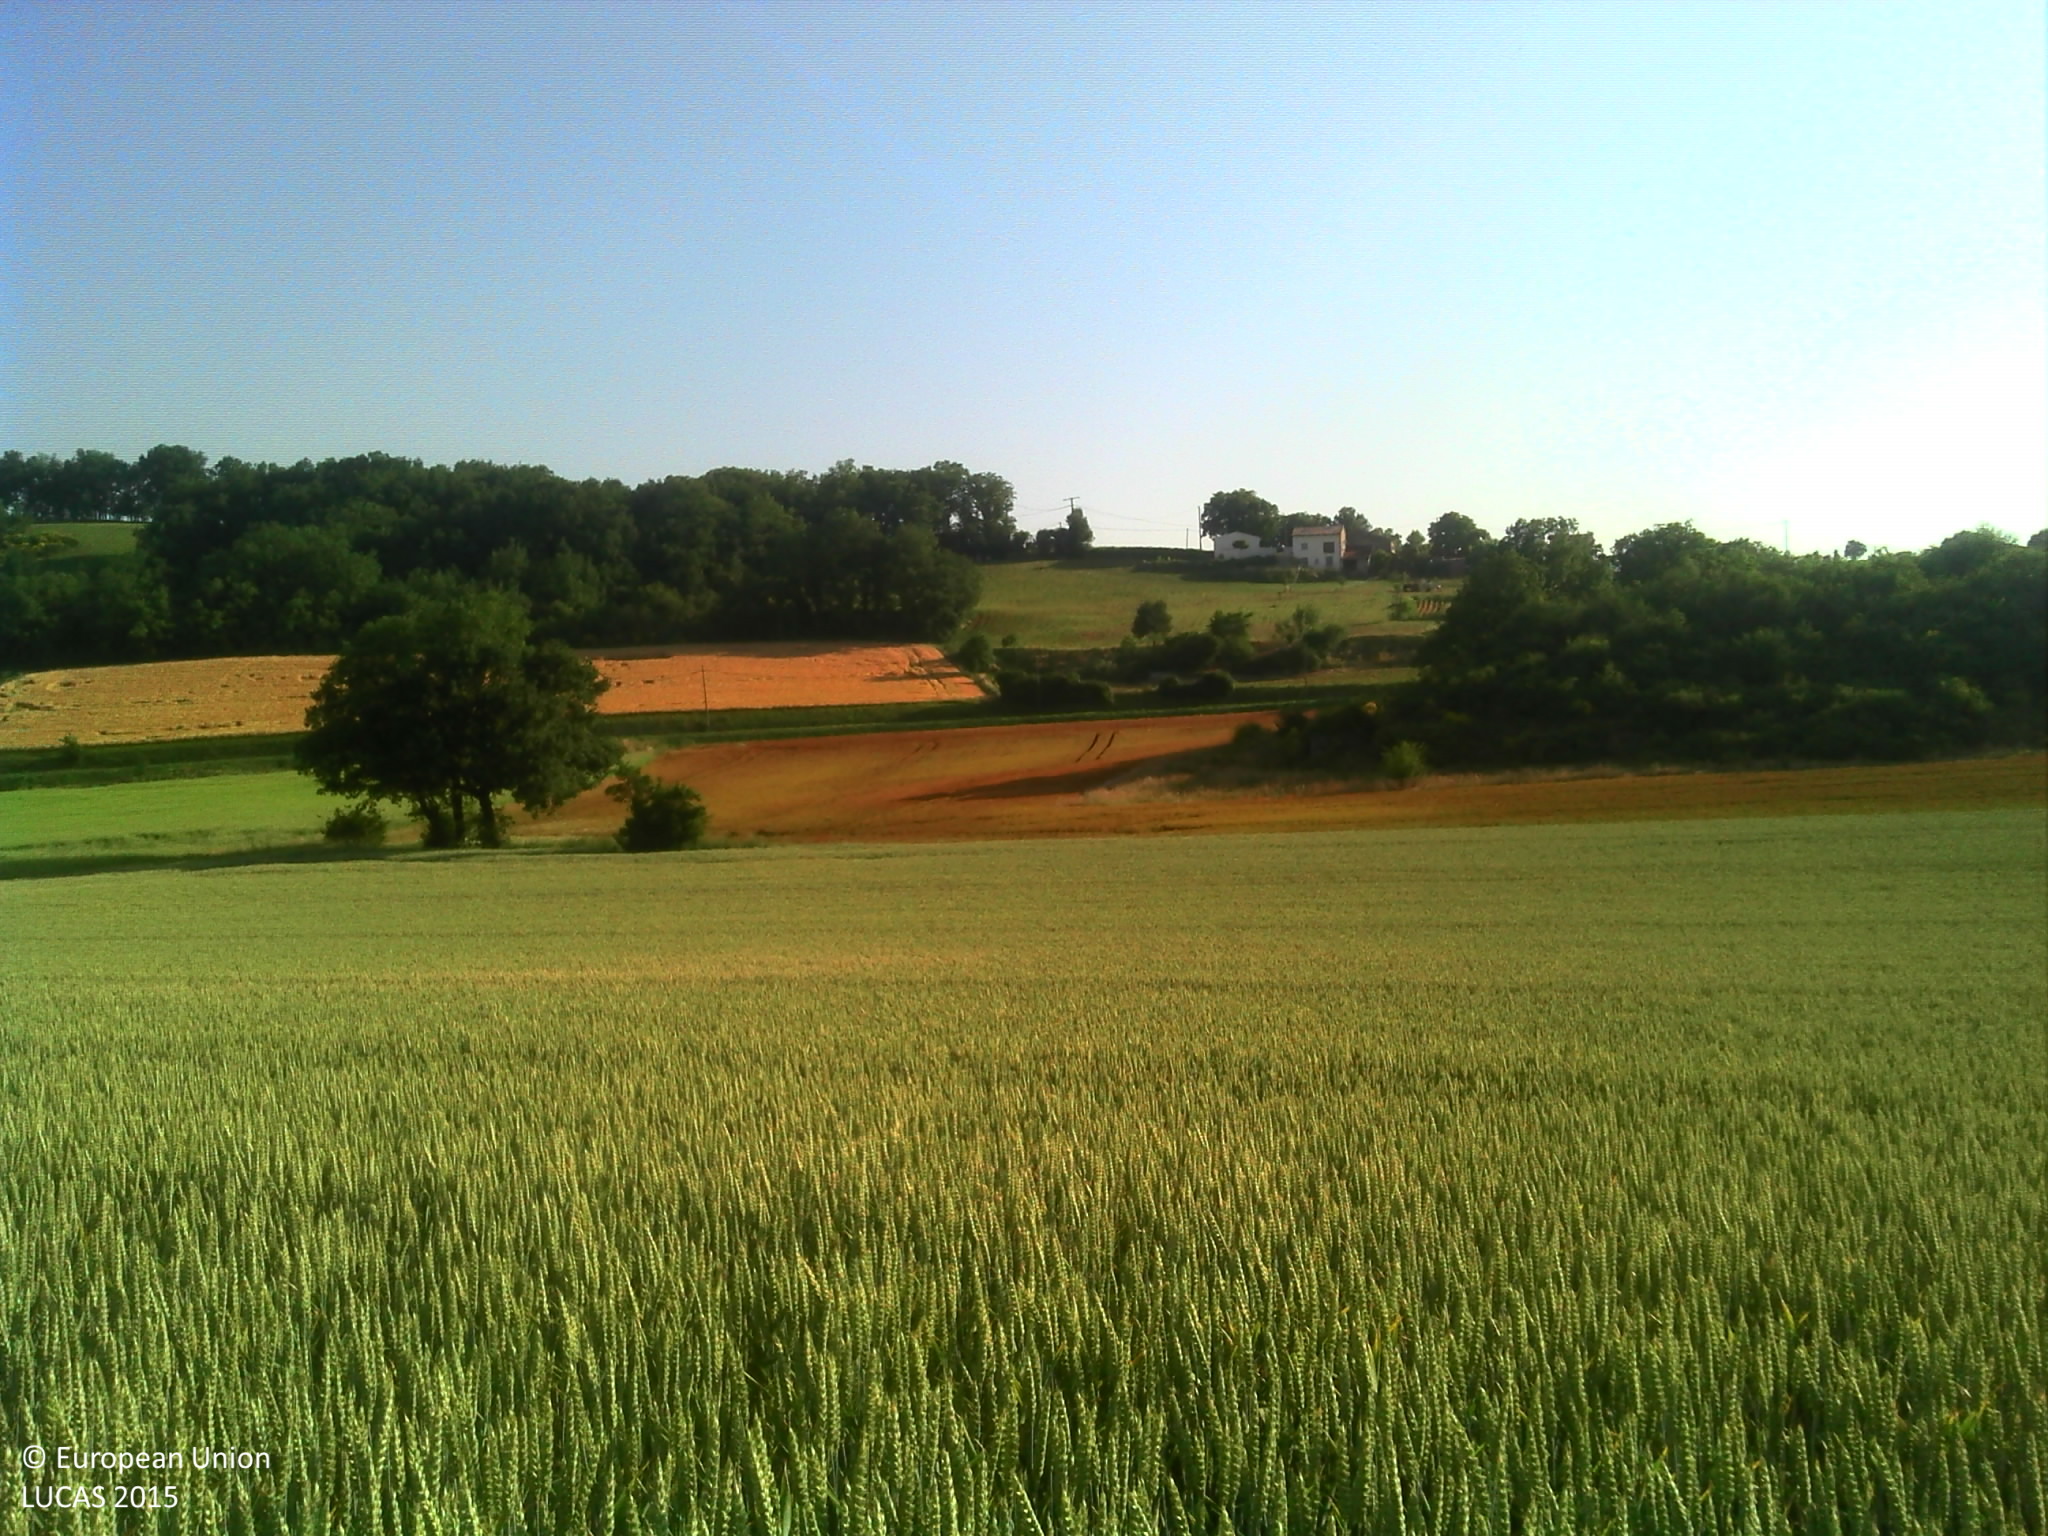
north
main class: Cropland
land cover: Common wheat
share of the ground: > 75 %
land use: Agriculture (excluding fallow land and kitchen gardens)
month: June
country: FR
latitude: 43.8860
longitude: 2.1000
